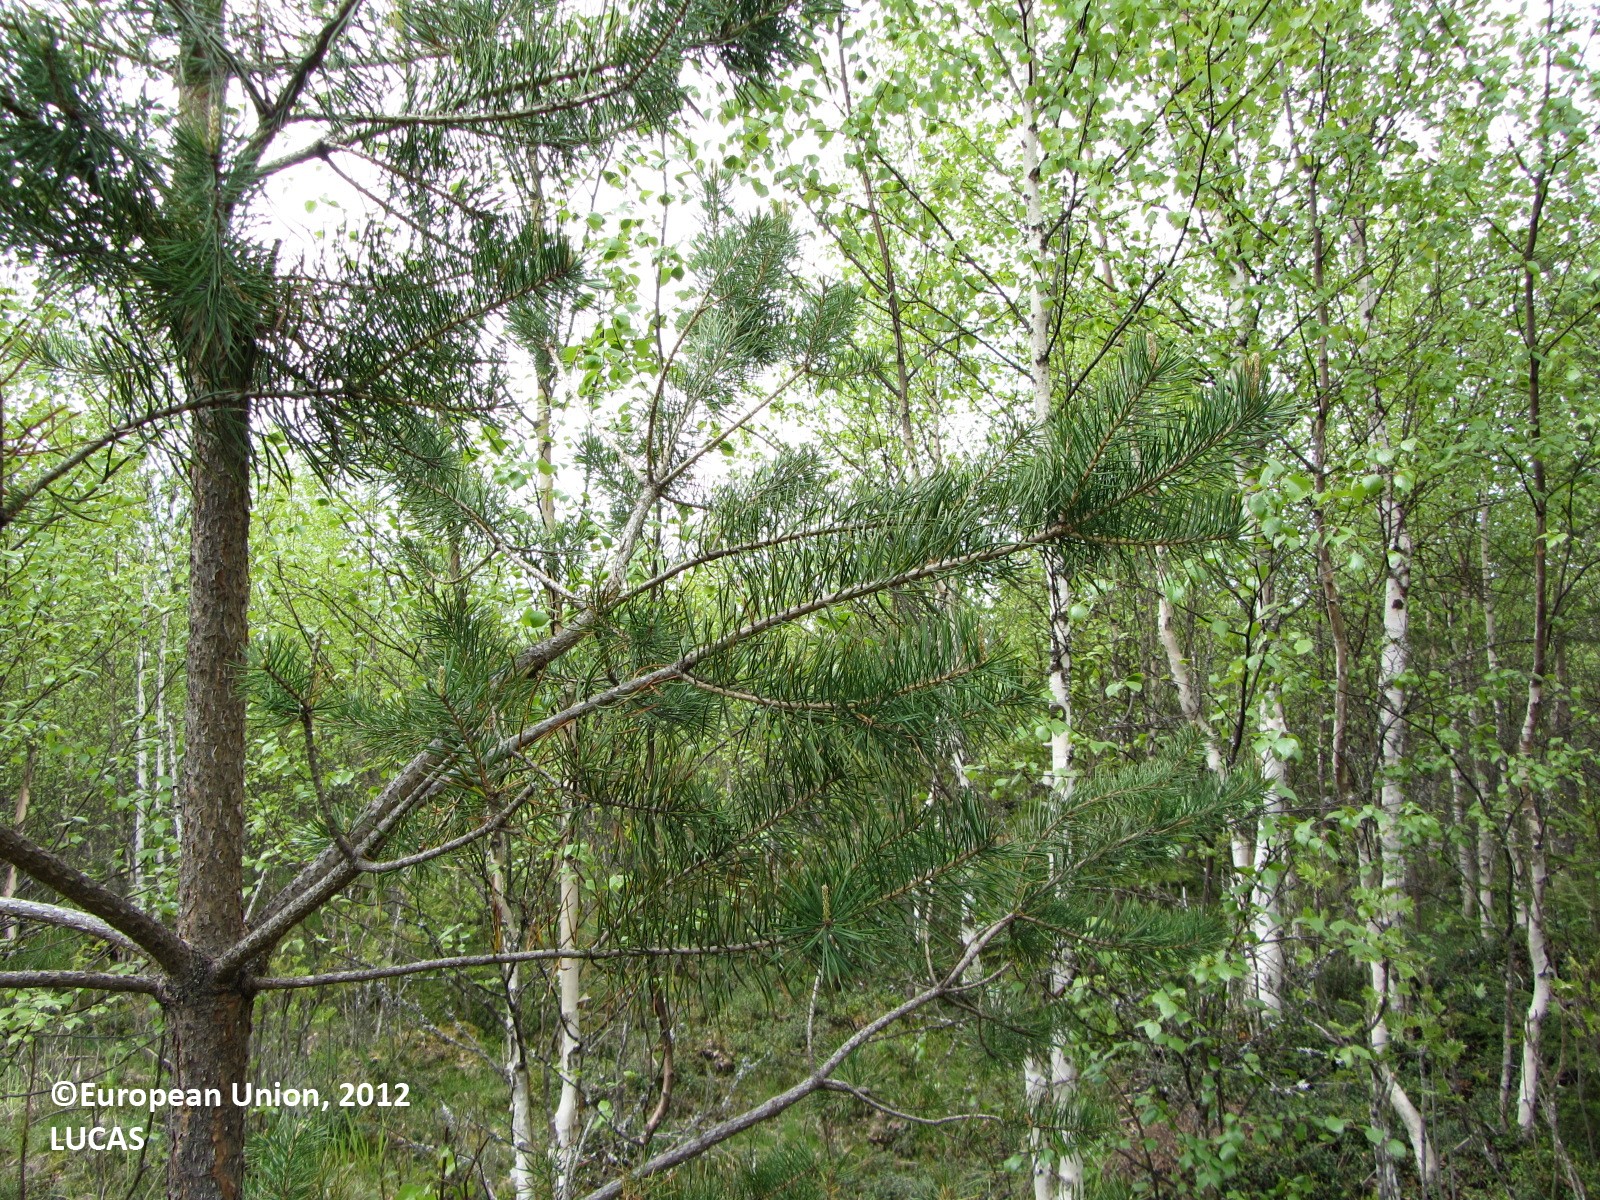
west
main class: Woodland
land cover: Pine dominated mixed woodland
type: boreal forest
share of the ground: > 75 %
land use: Forestry
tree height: < 5 m
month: June
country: FI
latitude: 63.8165
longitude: 24.7266
